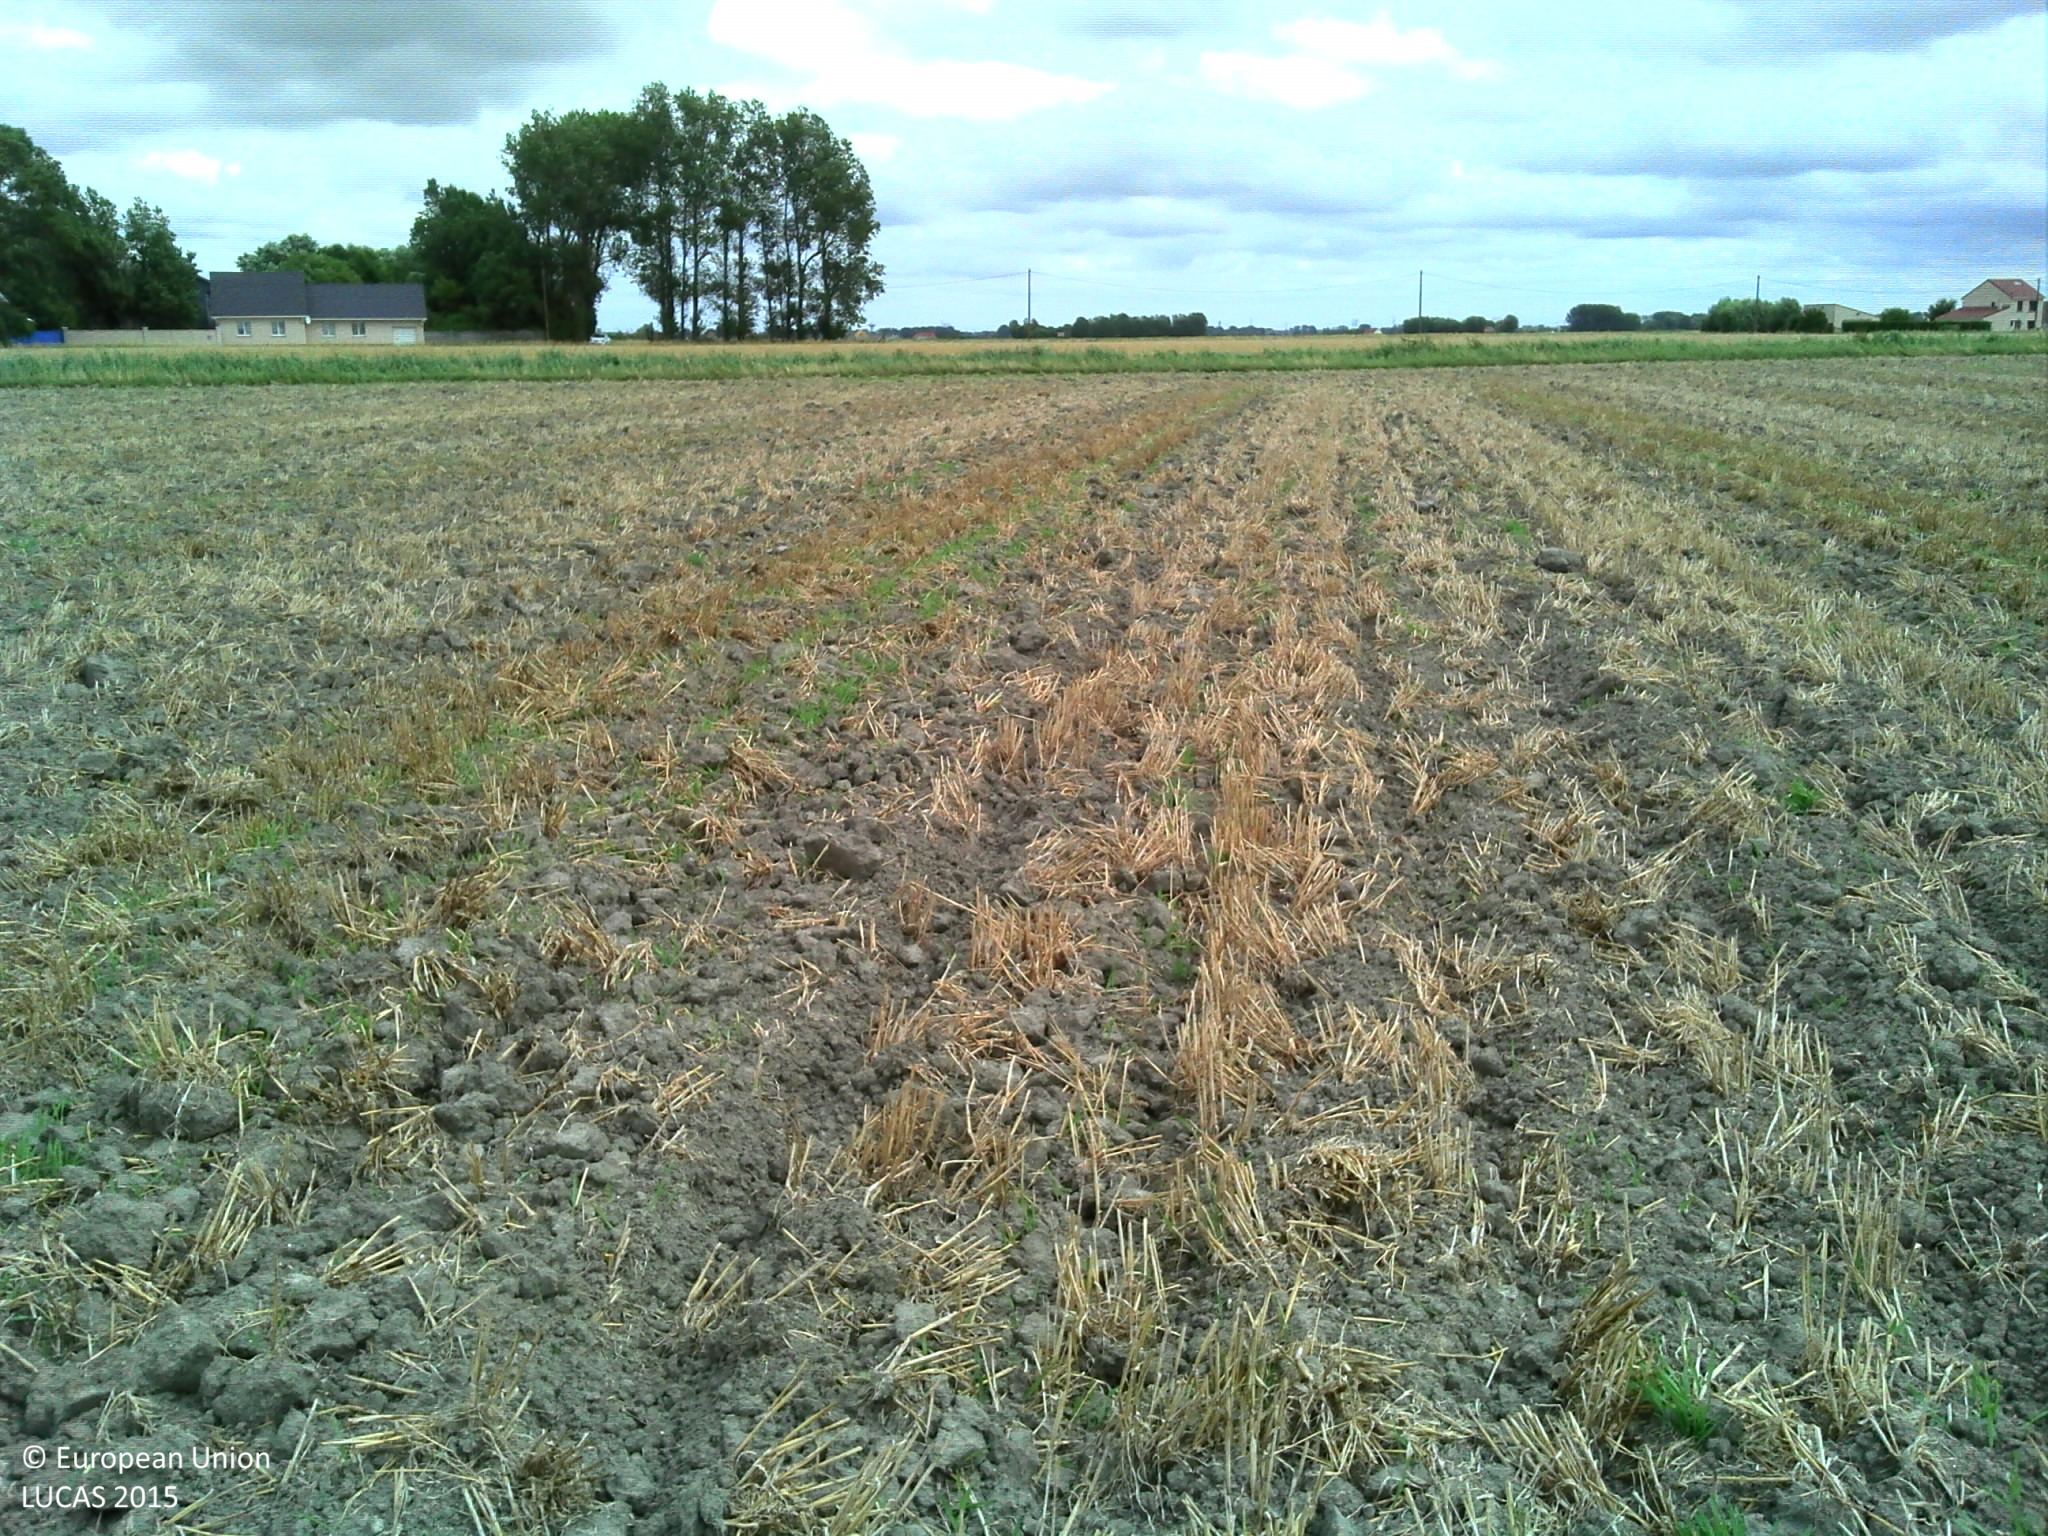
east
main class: Cropland
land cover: Barley
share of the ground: 10 - 25 %
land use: Agriculture (excluding fallow land and kitchen gardens)
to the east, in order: Barley; Grass margins; Ditches and canals; Grass margins; Common wheat; Grass margins; Paved roads, cycling and walking lanes; Grass margins; Ditches and canals; Grass margins; Other fibre and oleaginous crops
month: August
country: FR
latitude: 50.9726
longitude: 2.0521
